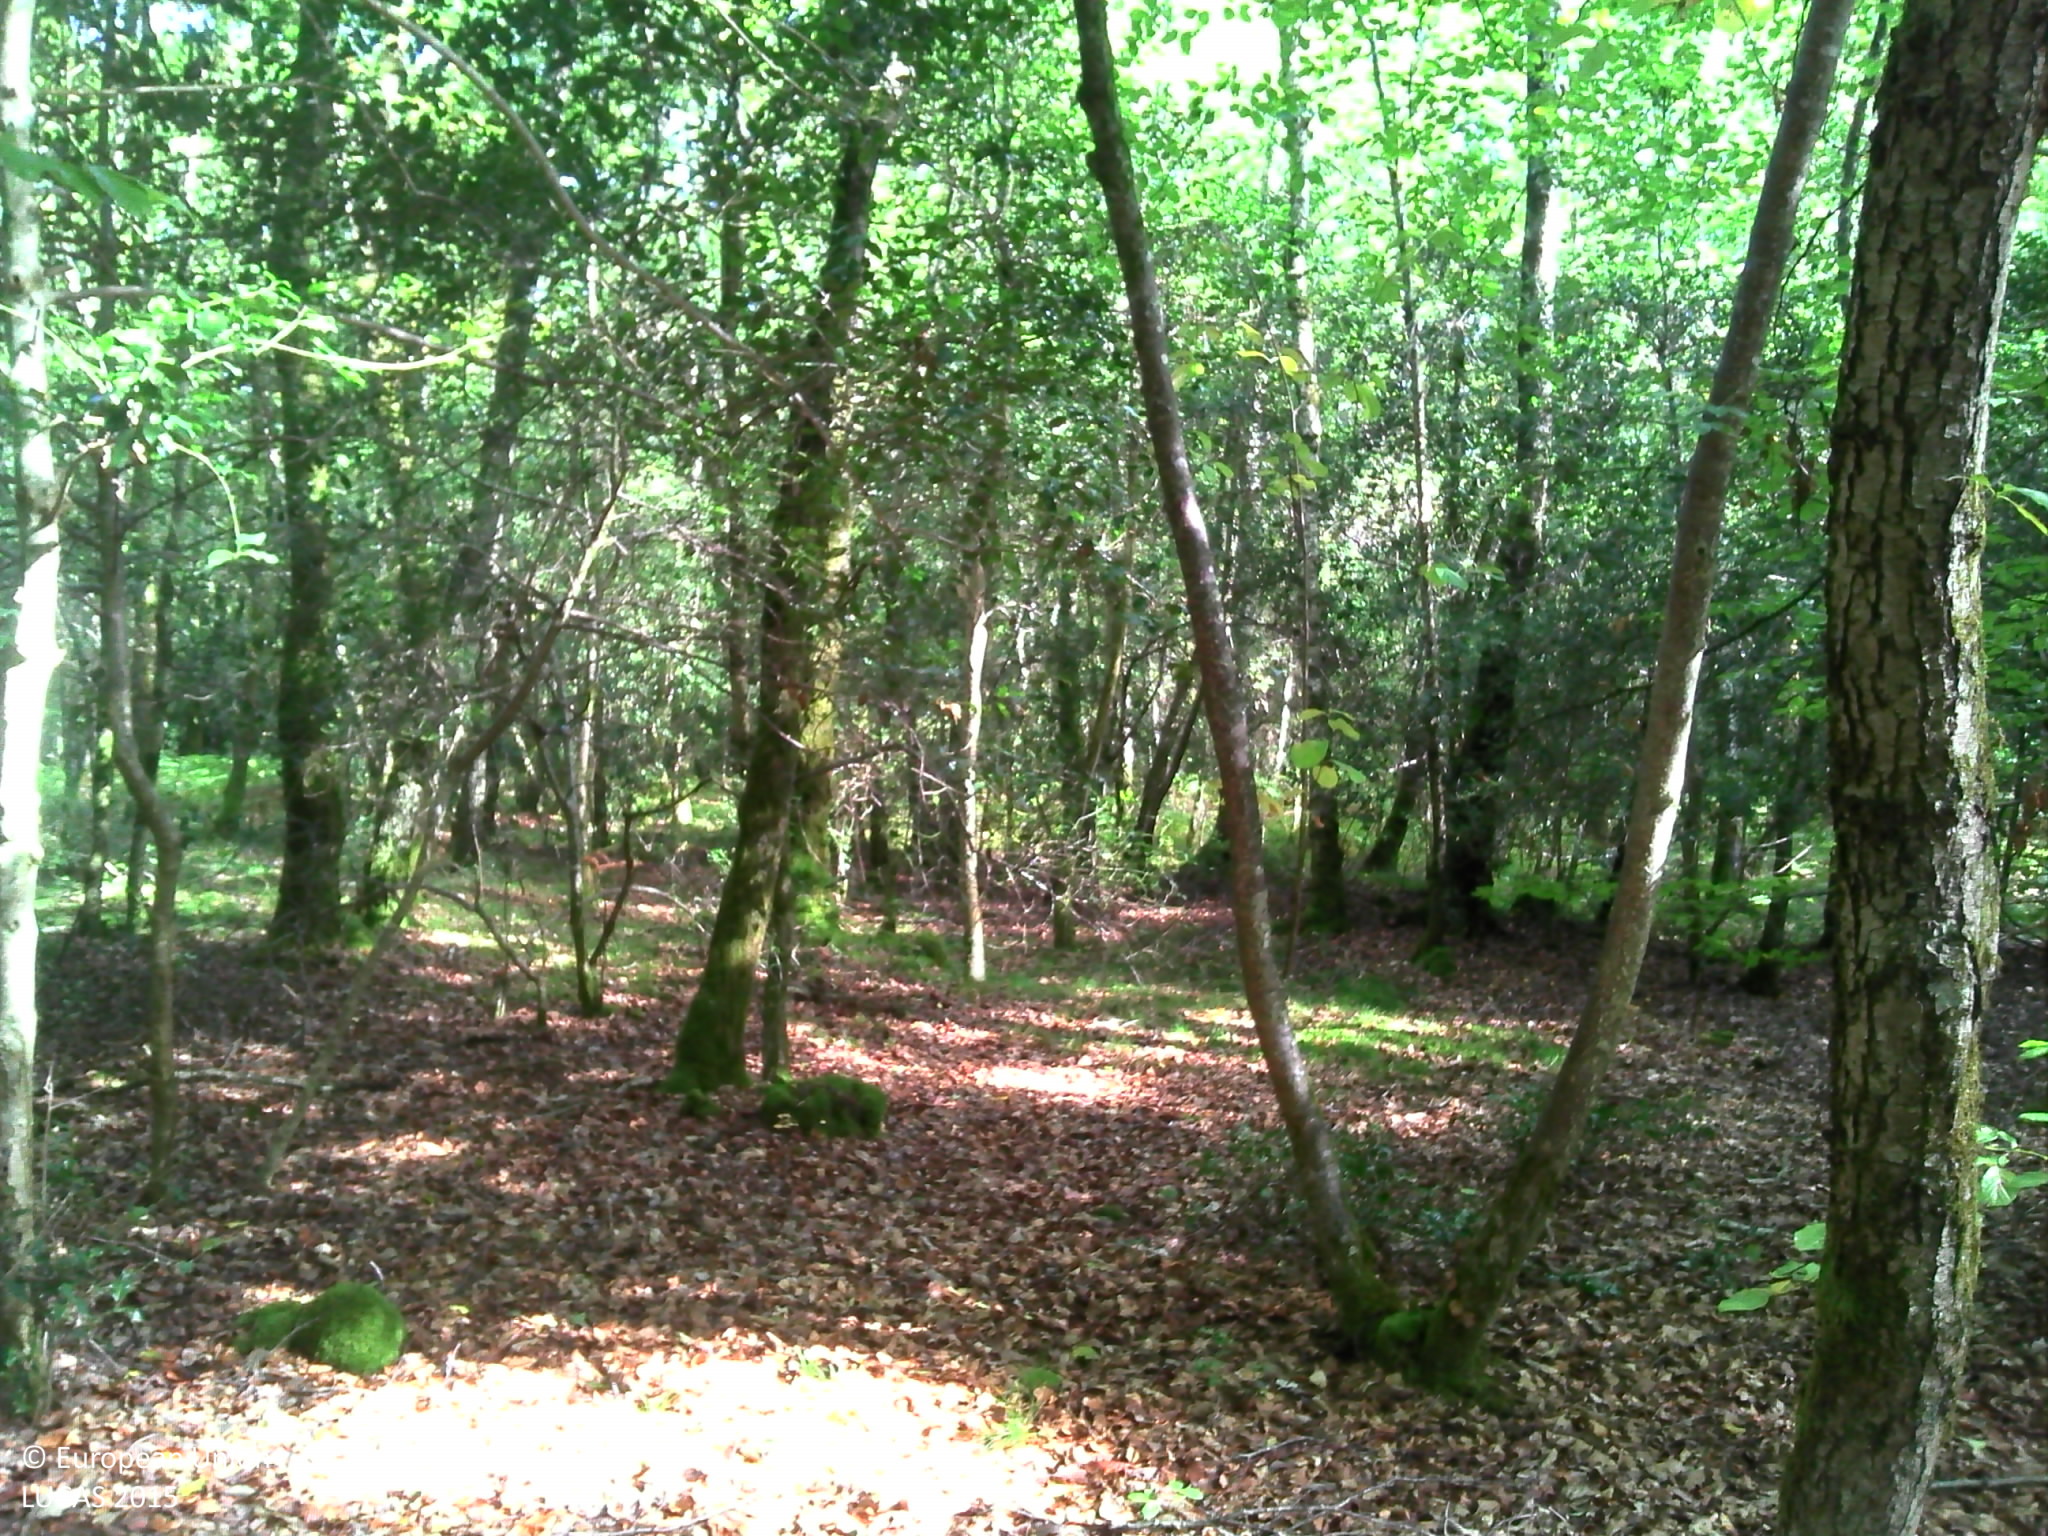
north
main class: Woodland
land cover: Broadleaved woodland
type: acidophilous oak and oak-birch forest
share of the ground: > 75 %
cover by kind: broadleaved forest trees 90 %, unconsolidated bare surface 10 %
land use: Forestry
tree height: > 5 m
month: June
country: FR
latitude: 47.2881
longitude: 2.6019
